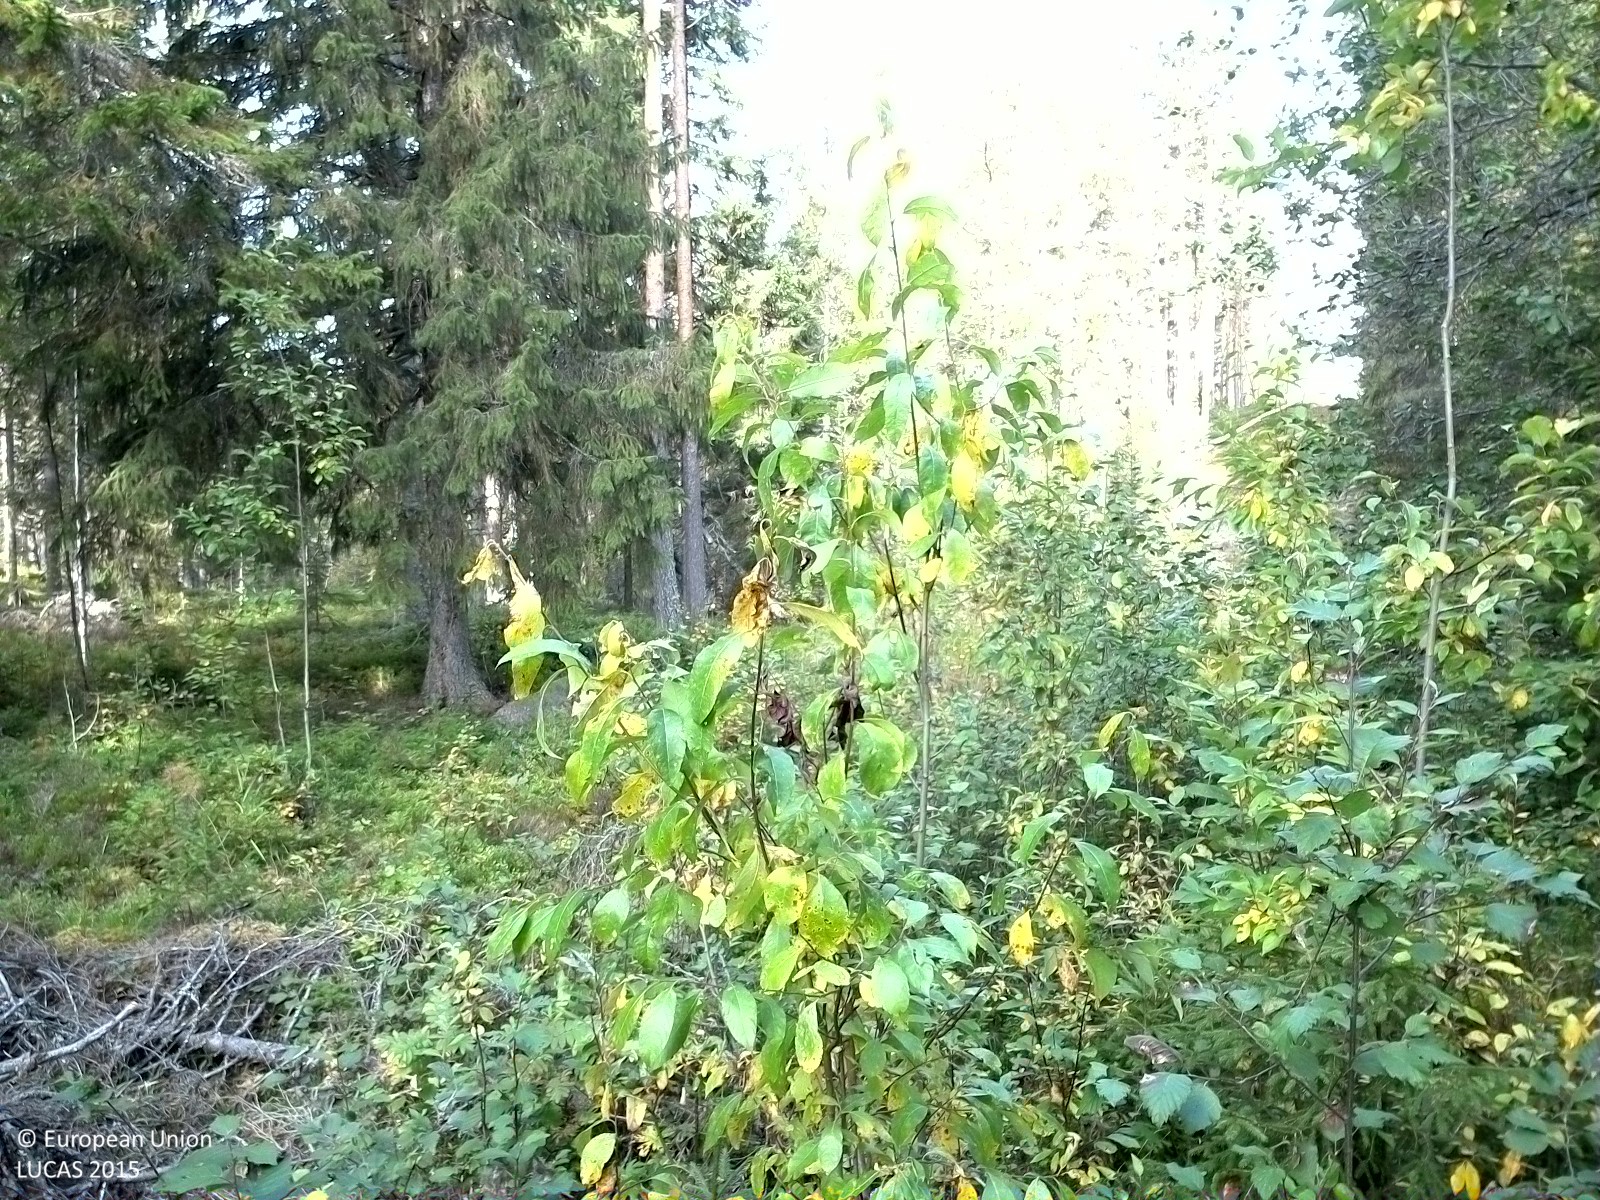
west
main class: Woodland
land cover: Spruce dominated mixed woodland
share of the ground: > 75 %
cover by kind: coniferous forest trees 40 %, broadleaved forest trees 35 %, shrubs 25 %
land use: Forestry
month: September
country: SE
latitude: 62.6035
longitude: 16.3876
